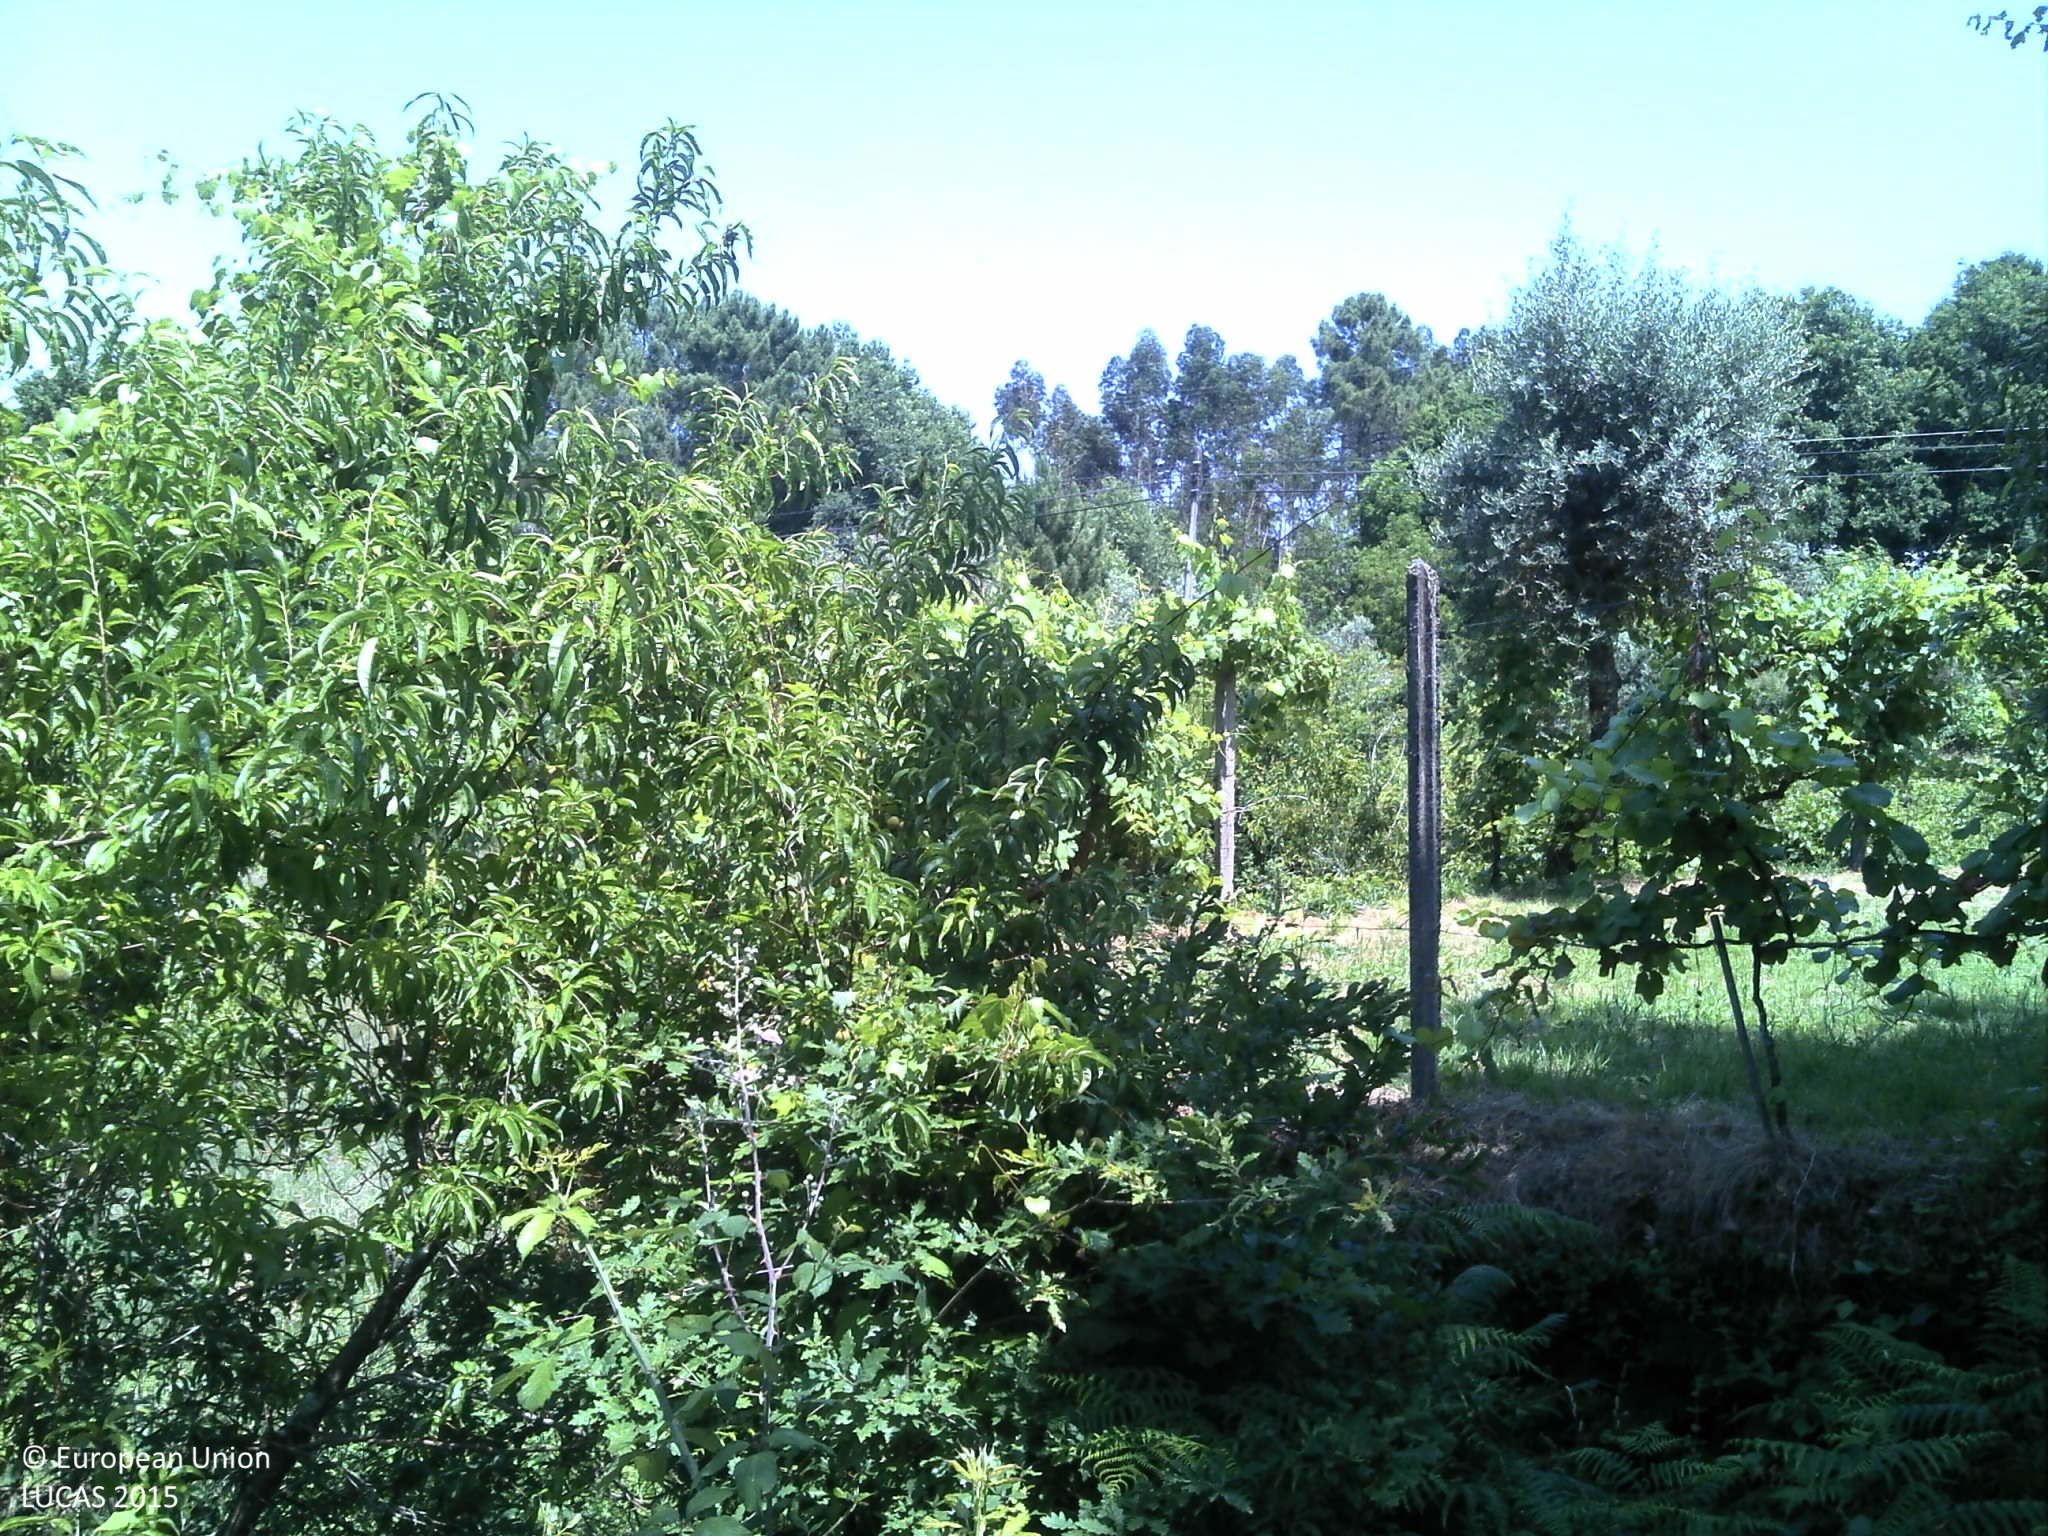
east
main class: Grassland
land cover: Grassland without tree/shrub cover
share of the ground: 50 - 75 %
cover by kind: herbaceous plants 75 %, unconsolidated bare surface 25 %
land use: Agriculture (excluding fallow land and kitchen gardens)
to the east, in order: Grassland without tree/shrub cover; Dry stone walls; Shrubland without tree cover; Tracks; Shrubland without tree cover; Dry stone walls; Grassland without tree/shrub cover; Broadleaved woodland; Tracks; Broadleaved woodland; Tracks; Broadleaved woodland; Paved roads, cycling and walking lanes; Shrubland with sparse tree cover
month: June
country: PT
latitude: 40.7276
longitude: -8.3108
